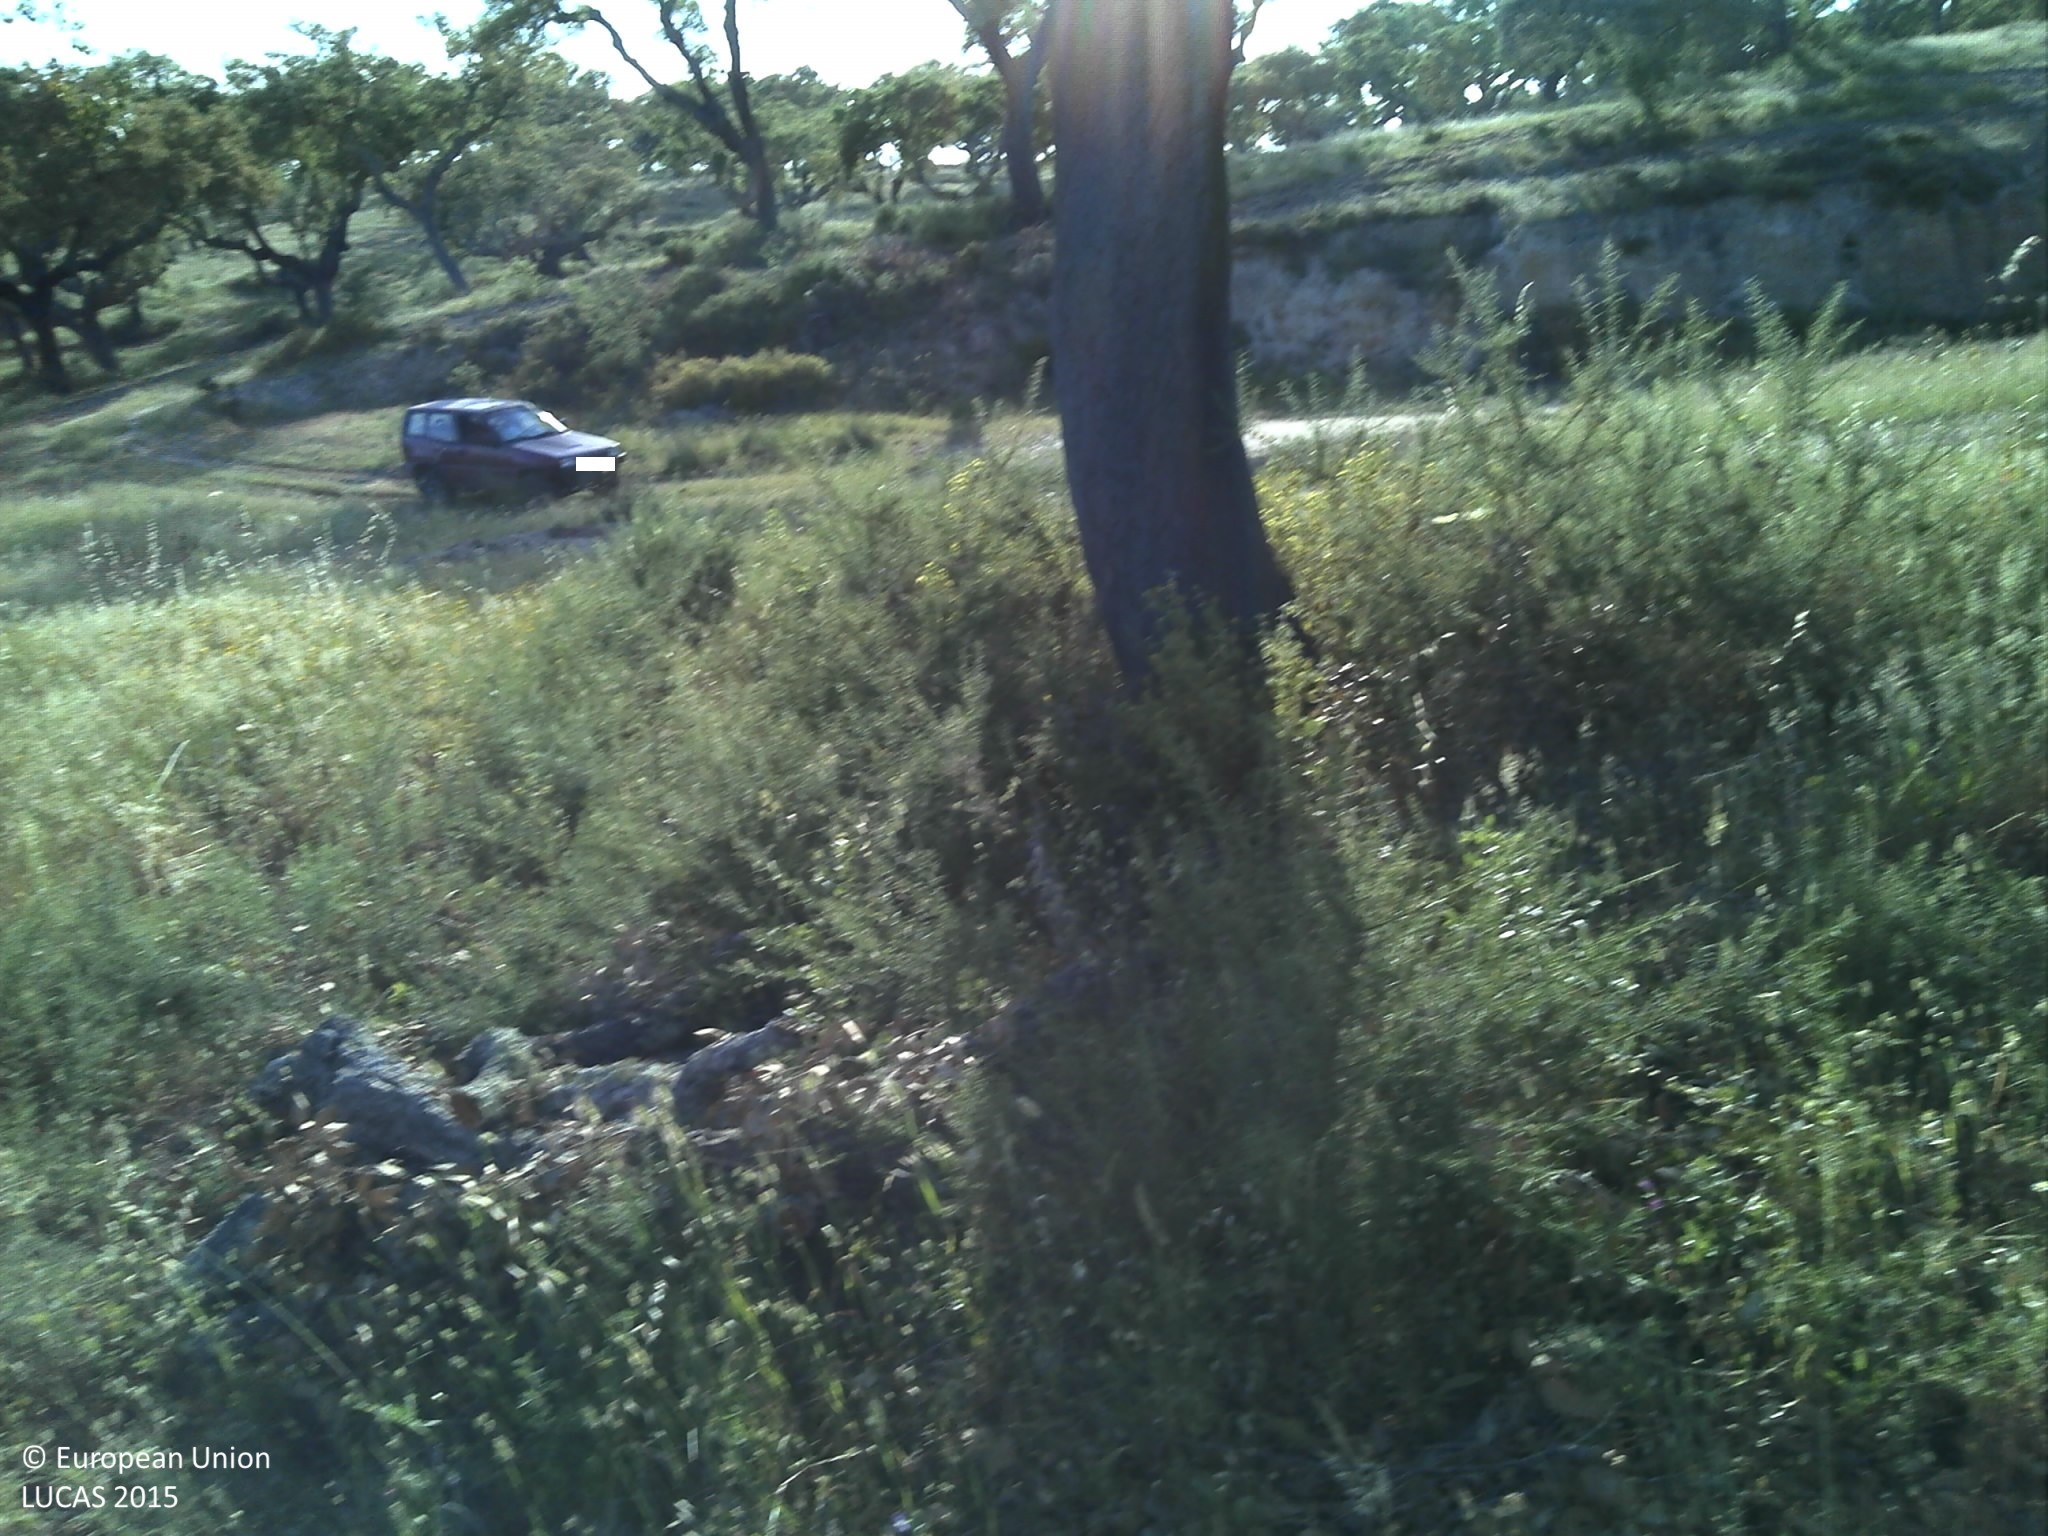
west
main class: Woodland
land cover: Broadleaved woodland
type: broadleaved evergreen forest
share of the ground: 25 - 50 %
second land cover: Grassland without tree/shrub cover
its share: 10 - 25 %
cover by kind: broadleaved forest trees 40 %, herbaceous plants 30 %, consolidated bare surface 30 %
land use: Forestry
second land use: Agriculture (excluding fallow land and kitchen gardens)
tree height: > 5 m
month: May
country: PT
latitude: 39.0845
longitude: -7.9102
